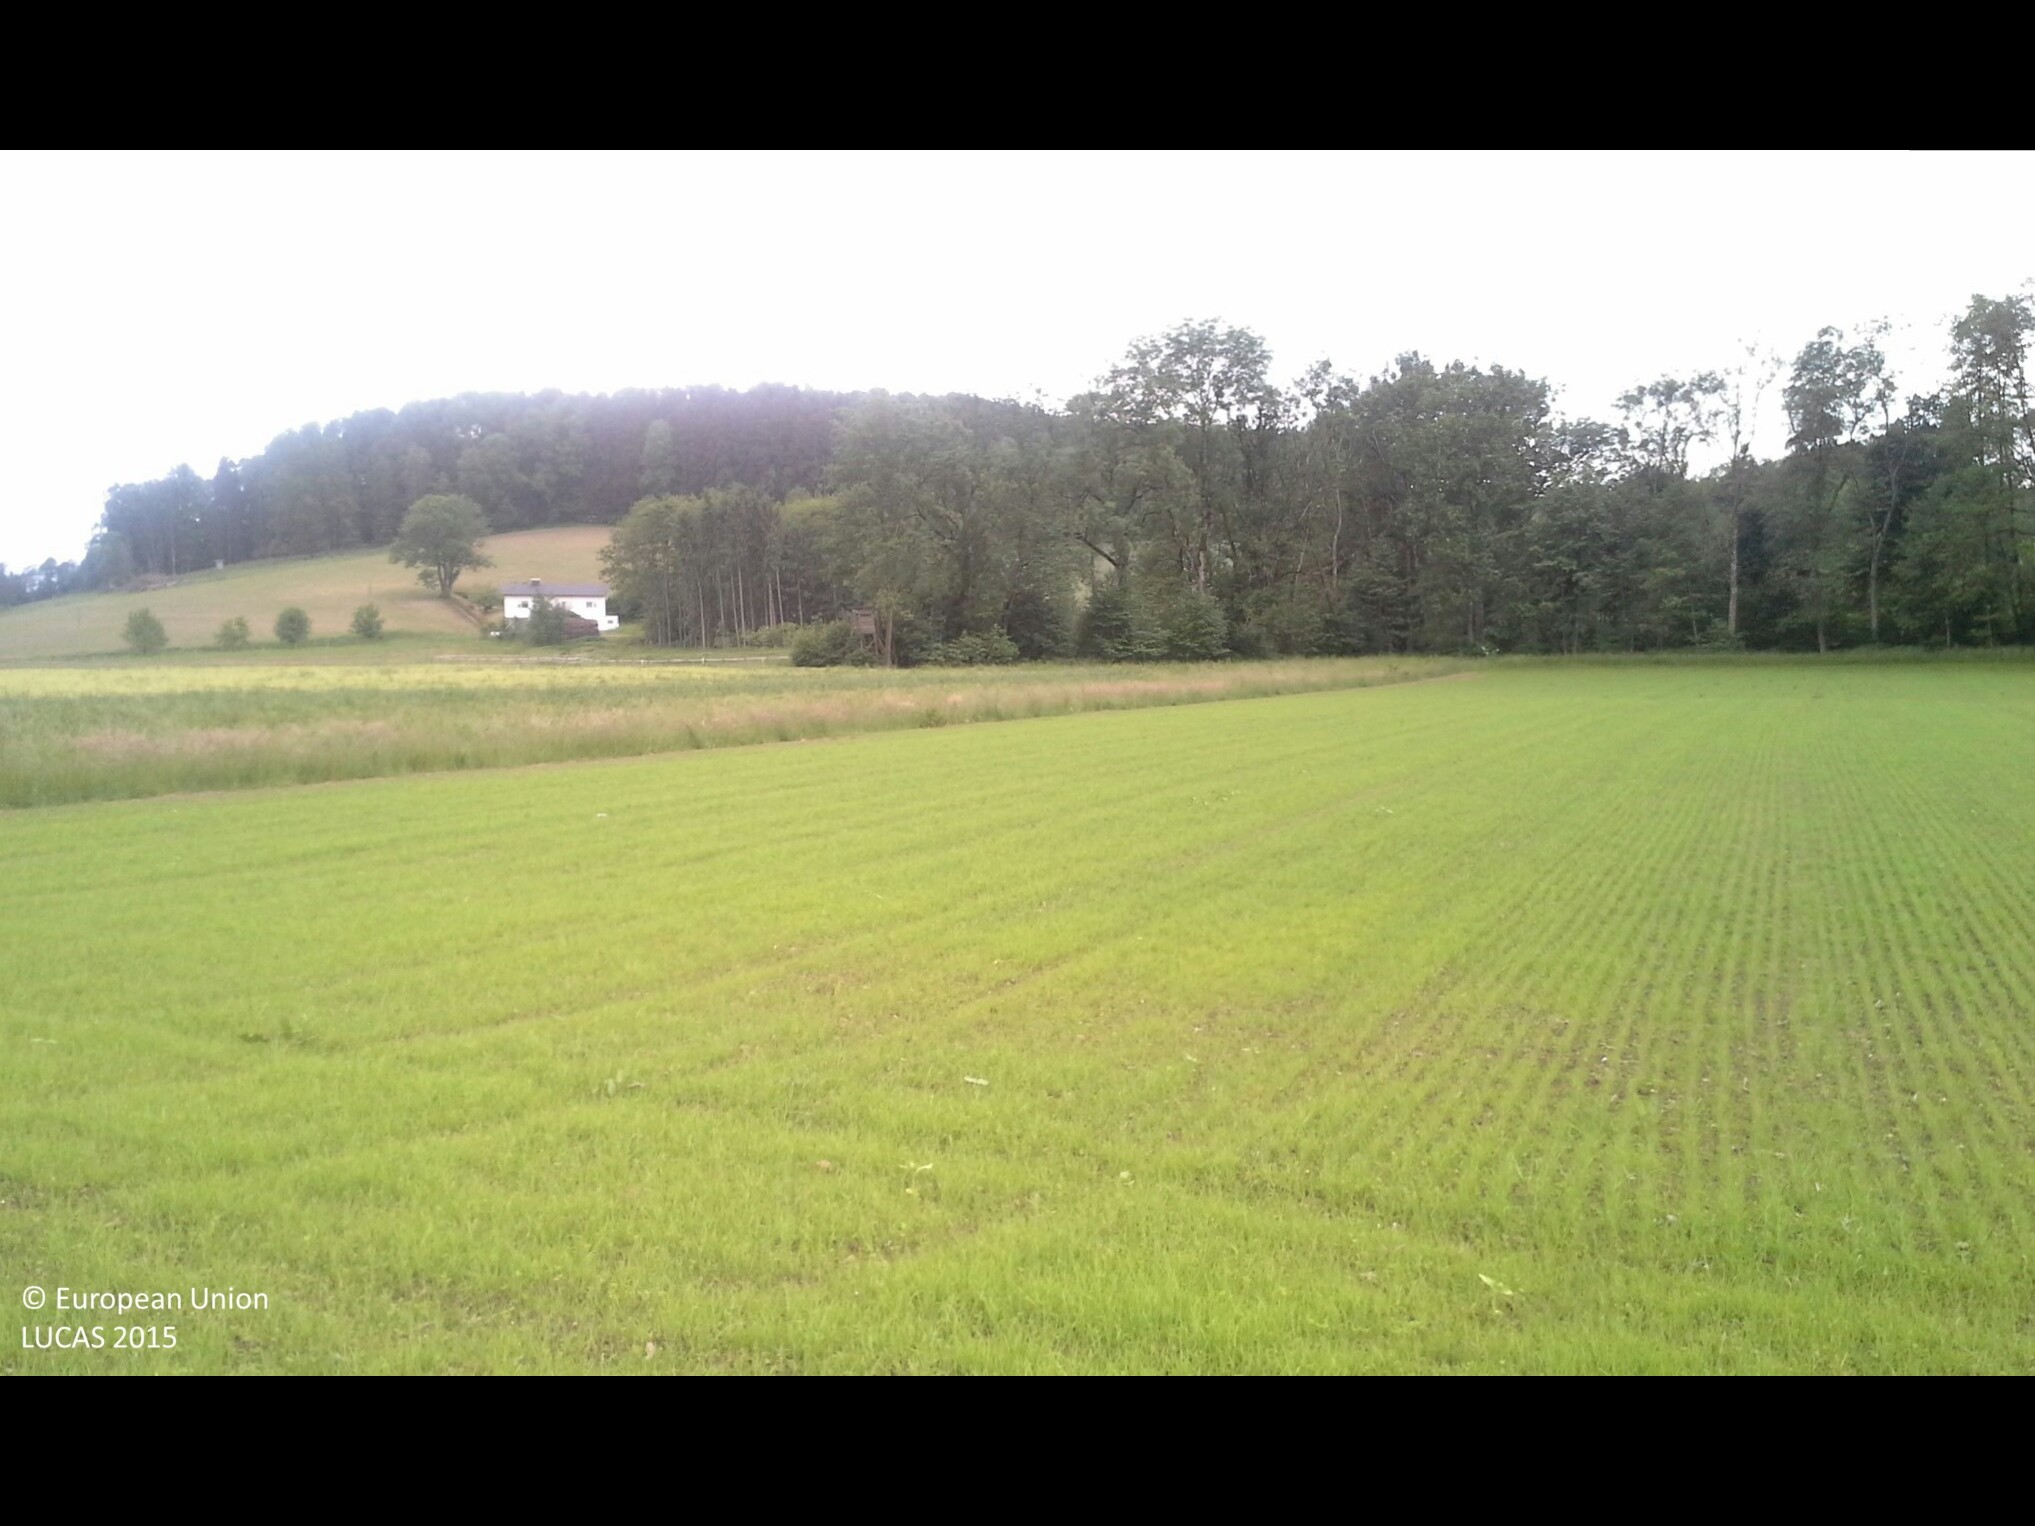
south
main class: Cropland
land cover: Temporary grasslands
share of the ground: > 75 %
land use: Agriculture (excluding fallow land and kitchen gardens)
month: May
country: AT
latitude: 48.0810
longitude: 14.4164
